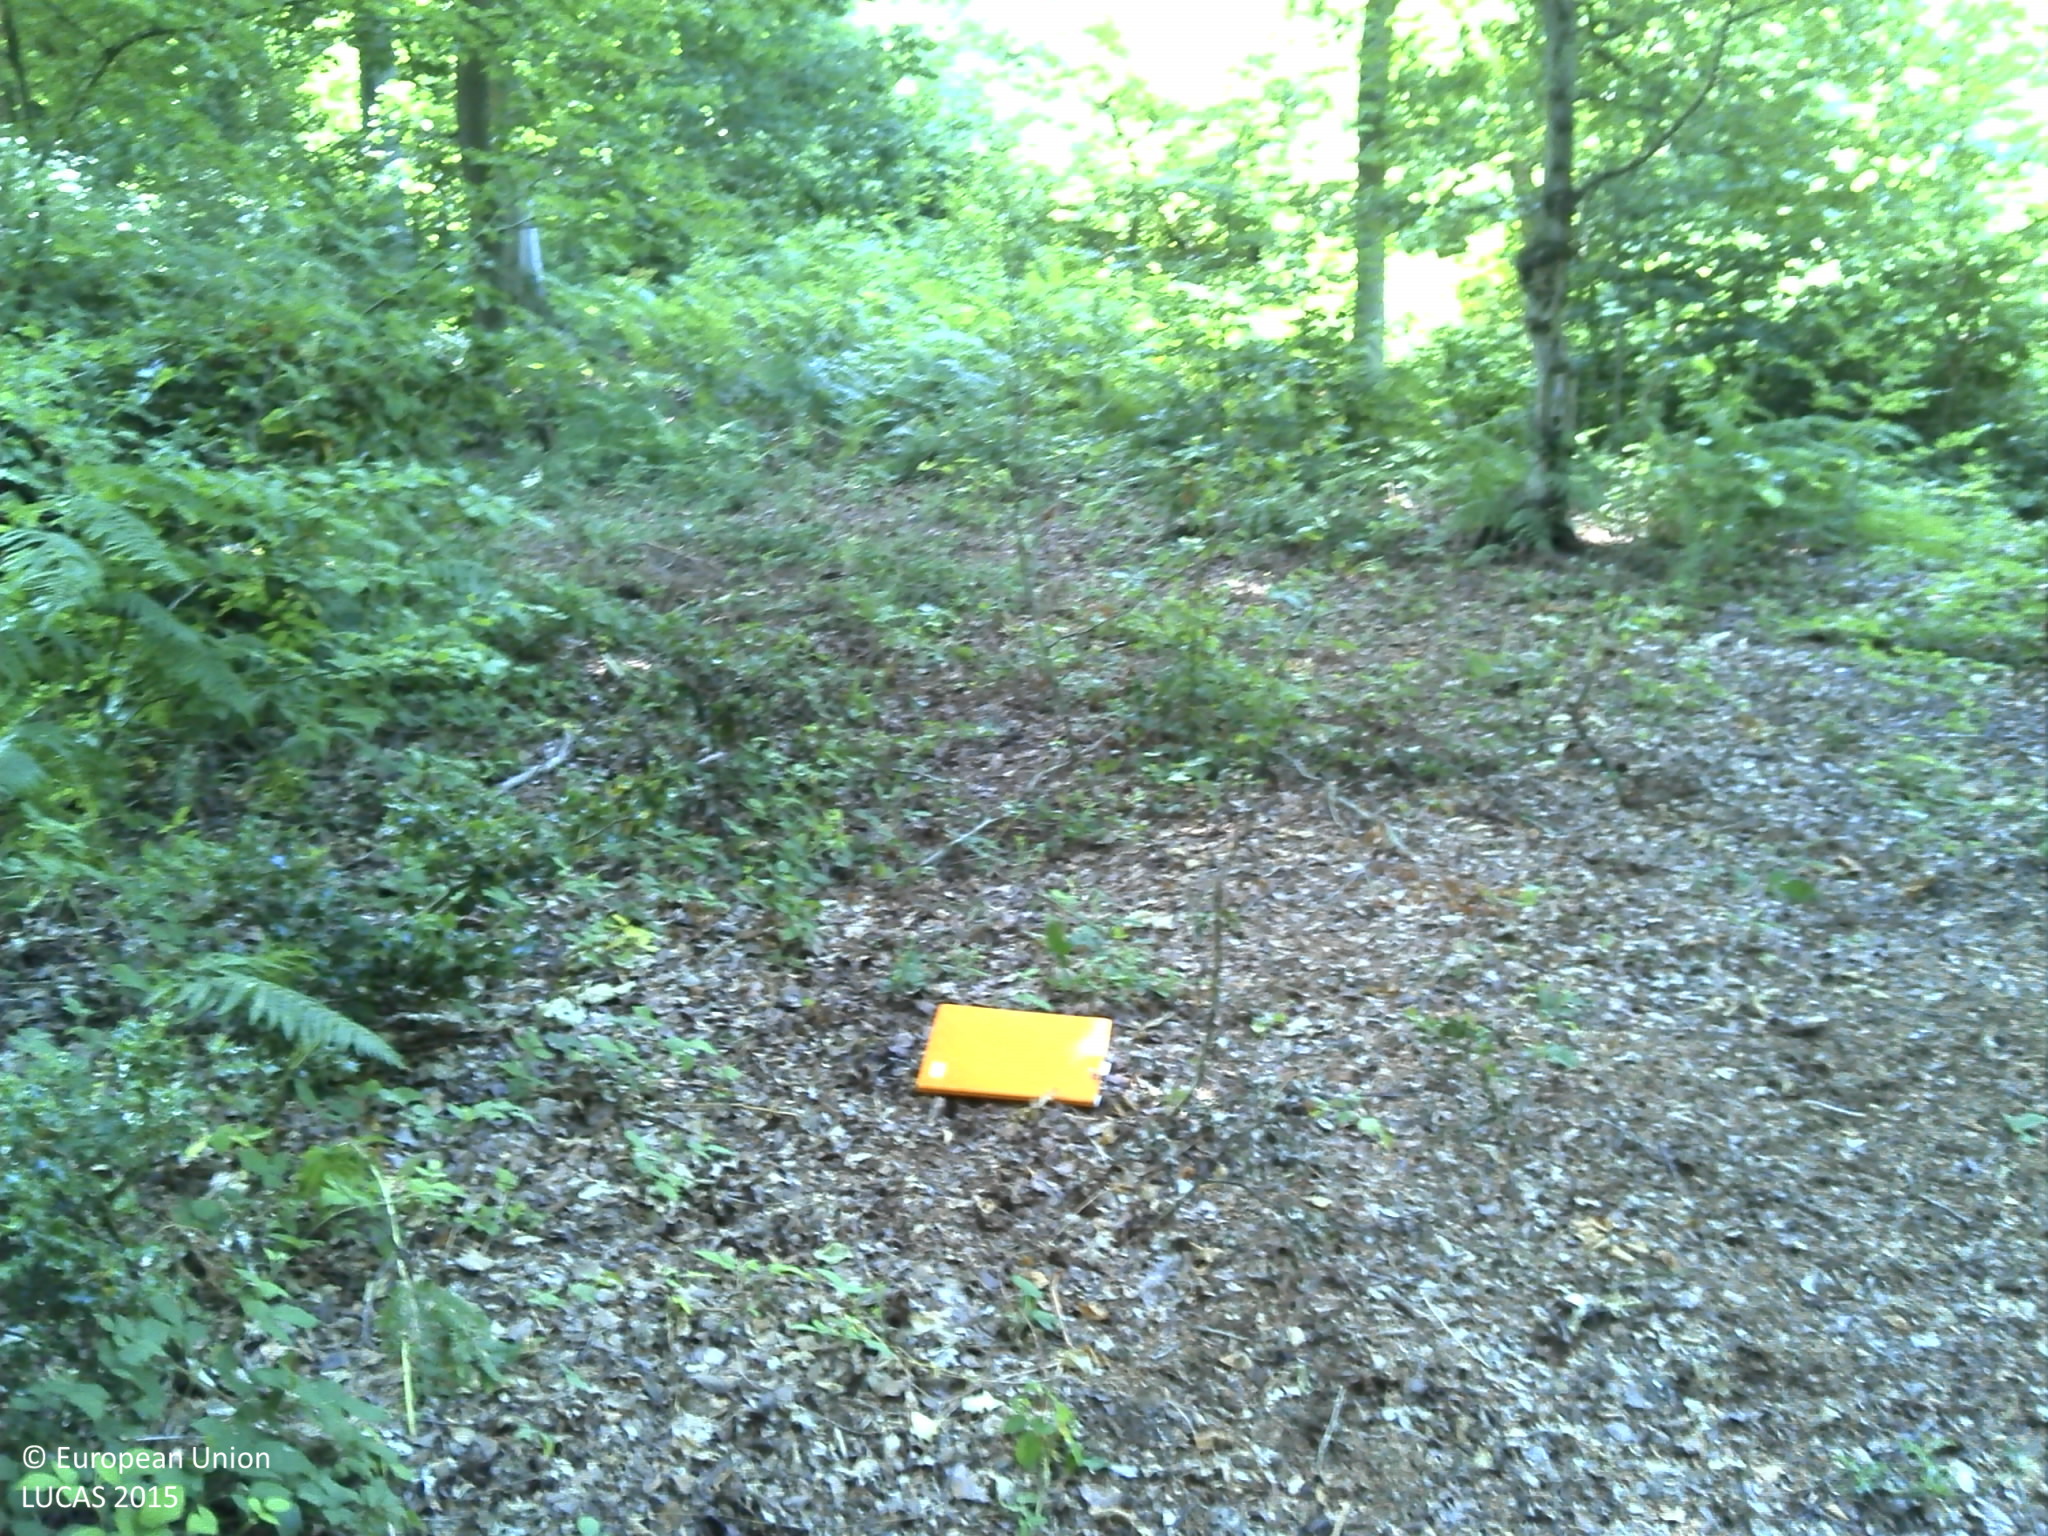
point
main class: Woodland
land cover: Broadleaved woodland
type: acidophilous oak and oak-birch forest
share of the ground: > 75 %
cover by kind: broadleaved forest trees 100 %
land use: Forestry
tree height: > 5 m
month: June
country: FR
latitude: 49.4297
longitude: 1.0017
